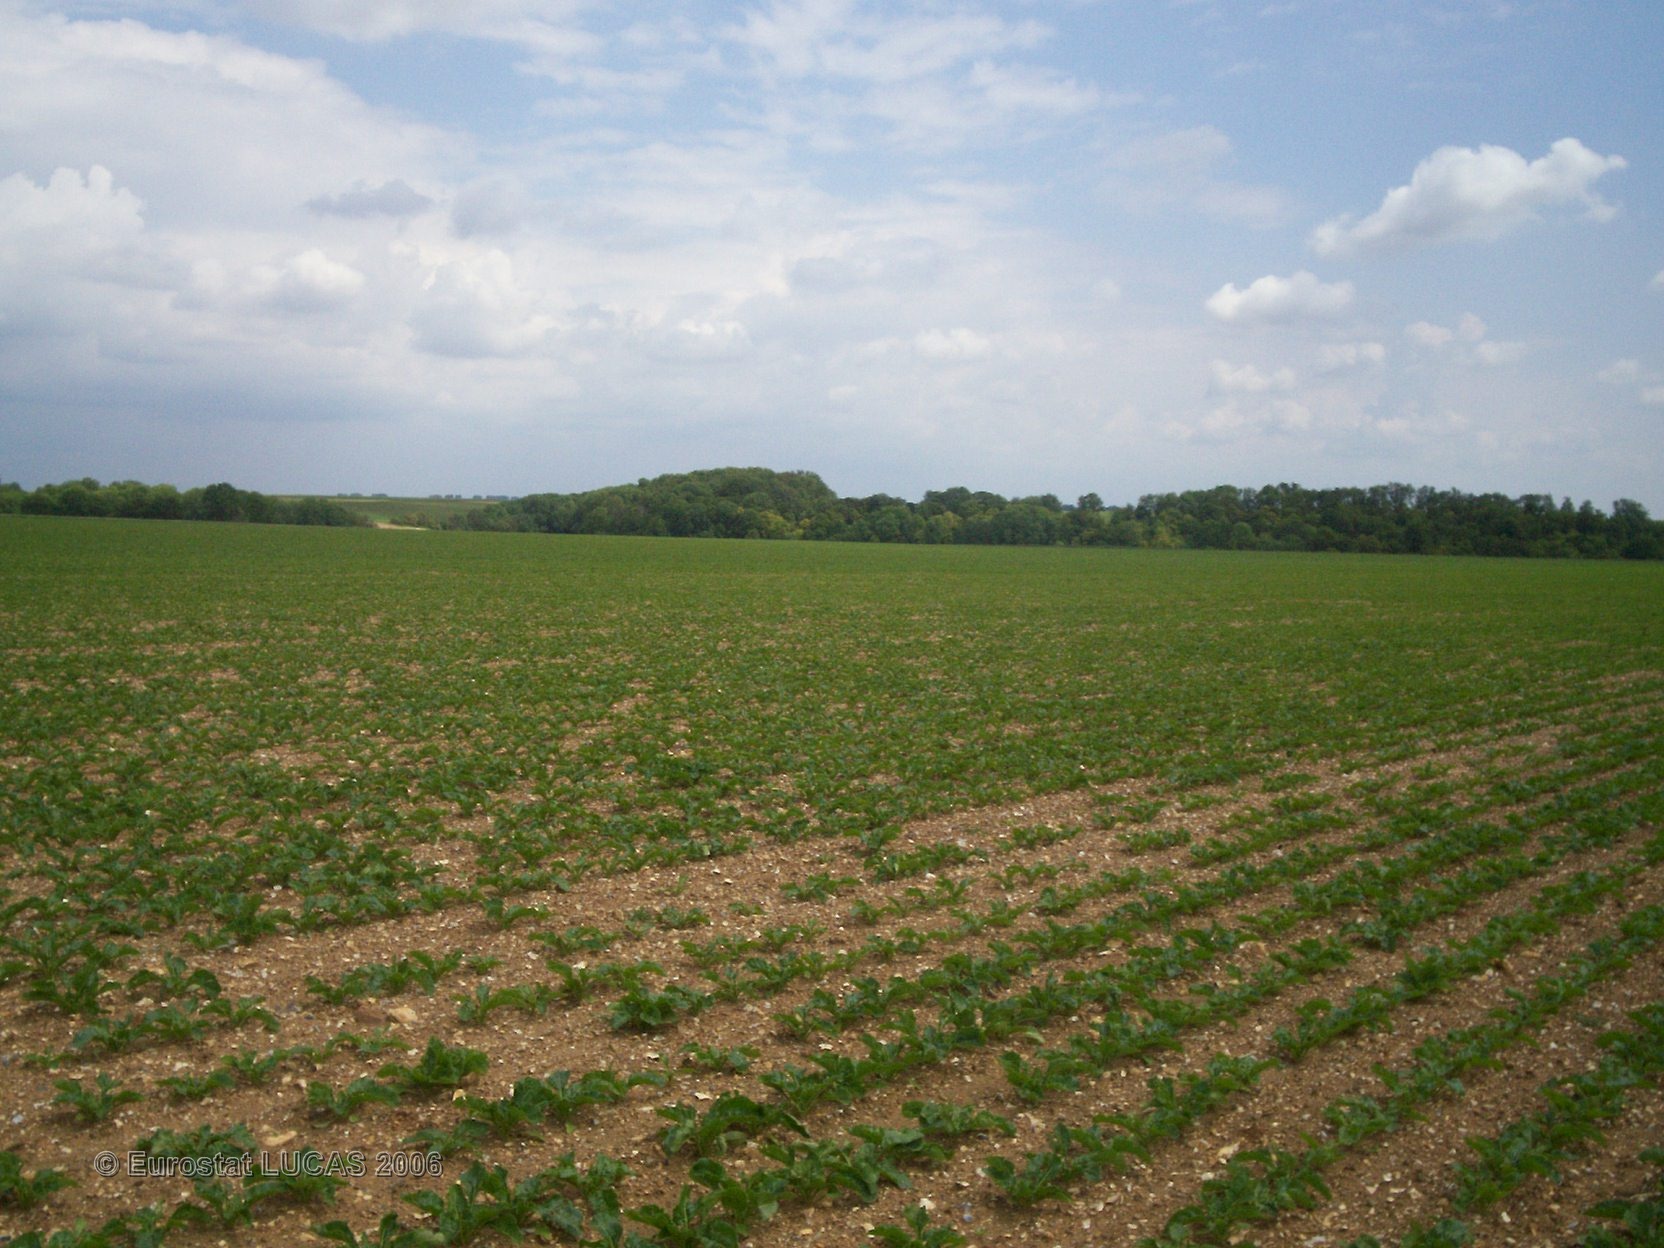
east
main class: Cropland
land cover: Sugar beet
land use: Agriculture (excluding fallow land and kitchen gardens)
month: June
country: FR
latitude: 49.7283
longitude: 2.6220
